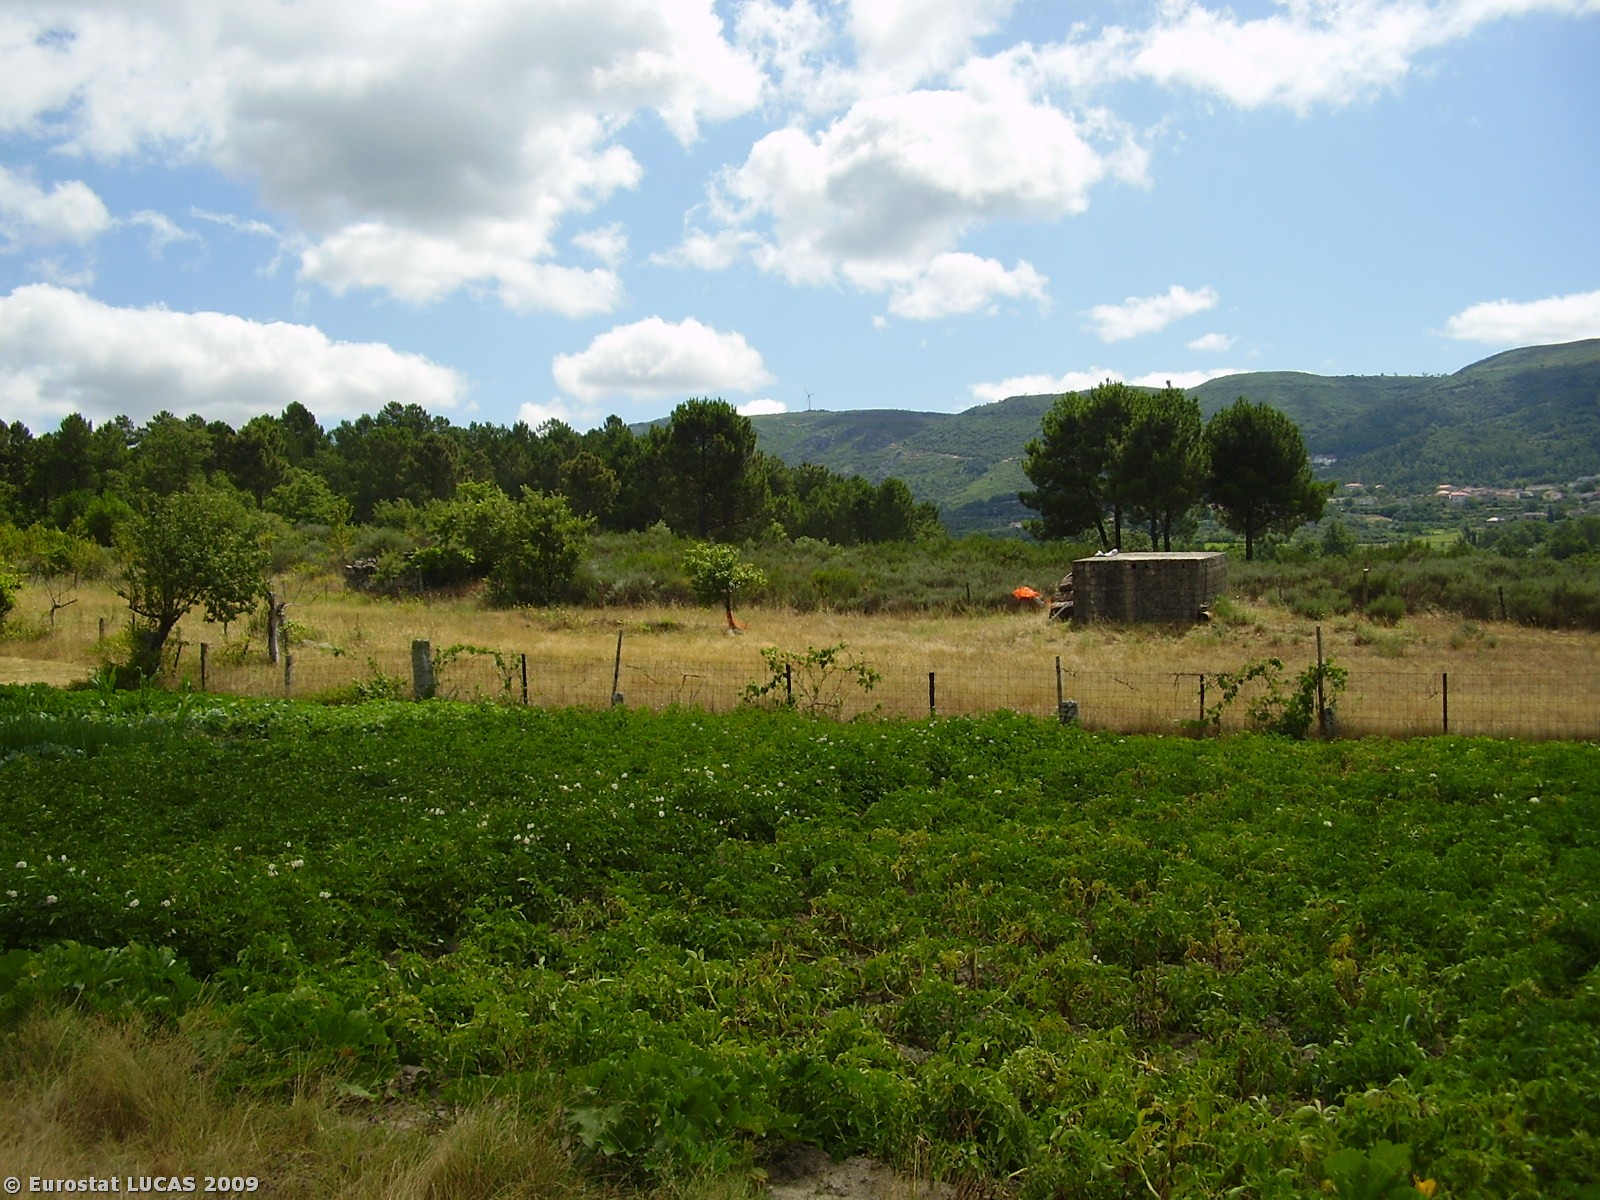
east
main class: Grassland
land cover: Spontaneously vegetated surfaces
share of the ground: > 75 %
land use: Fallow land
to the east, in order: Spontaneously vegetated surfaces; Ditches and canals; Dry stone walls; Fences; Spontaneously vegetated surfaces; Fences; Shrubland with sparse tree cover; Fences; Coniferous woodland; Fences; Vineyards; Shrubland without tree cover; Coniferous woodland
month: July
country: PT
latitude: 41.5636
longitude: -7.5775
